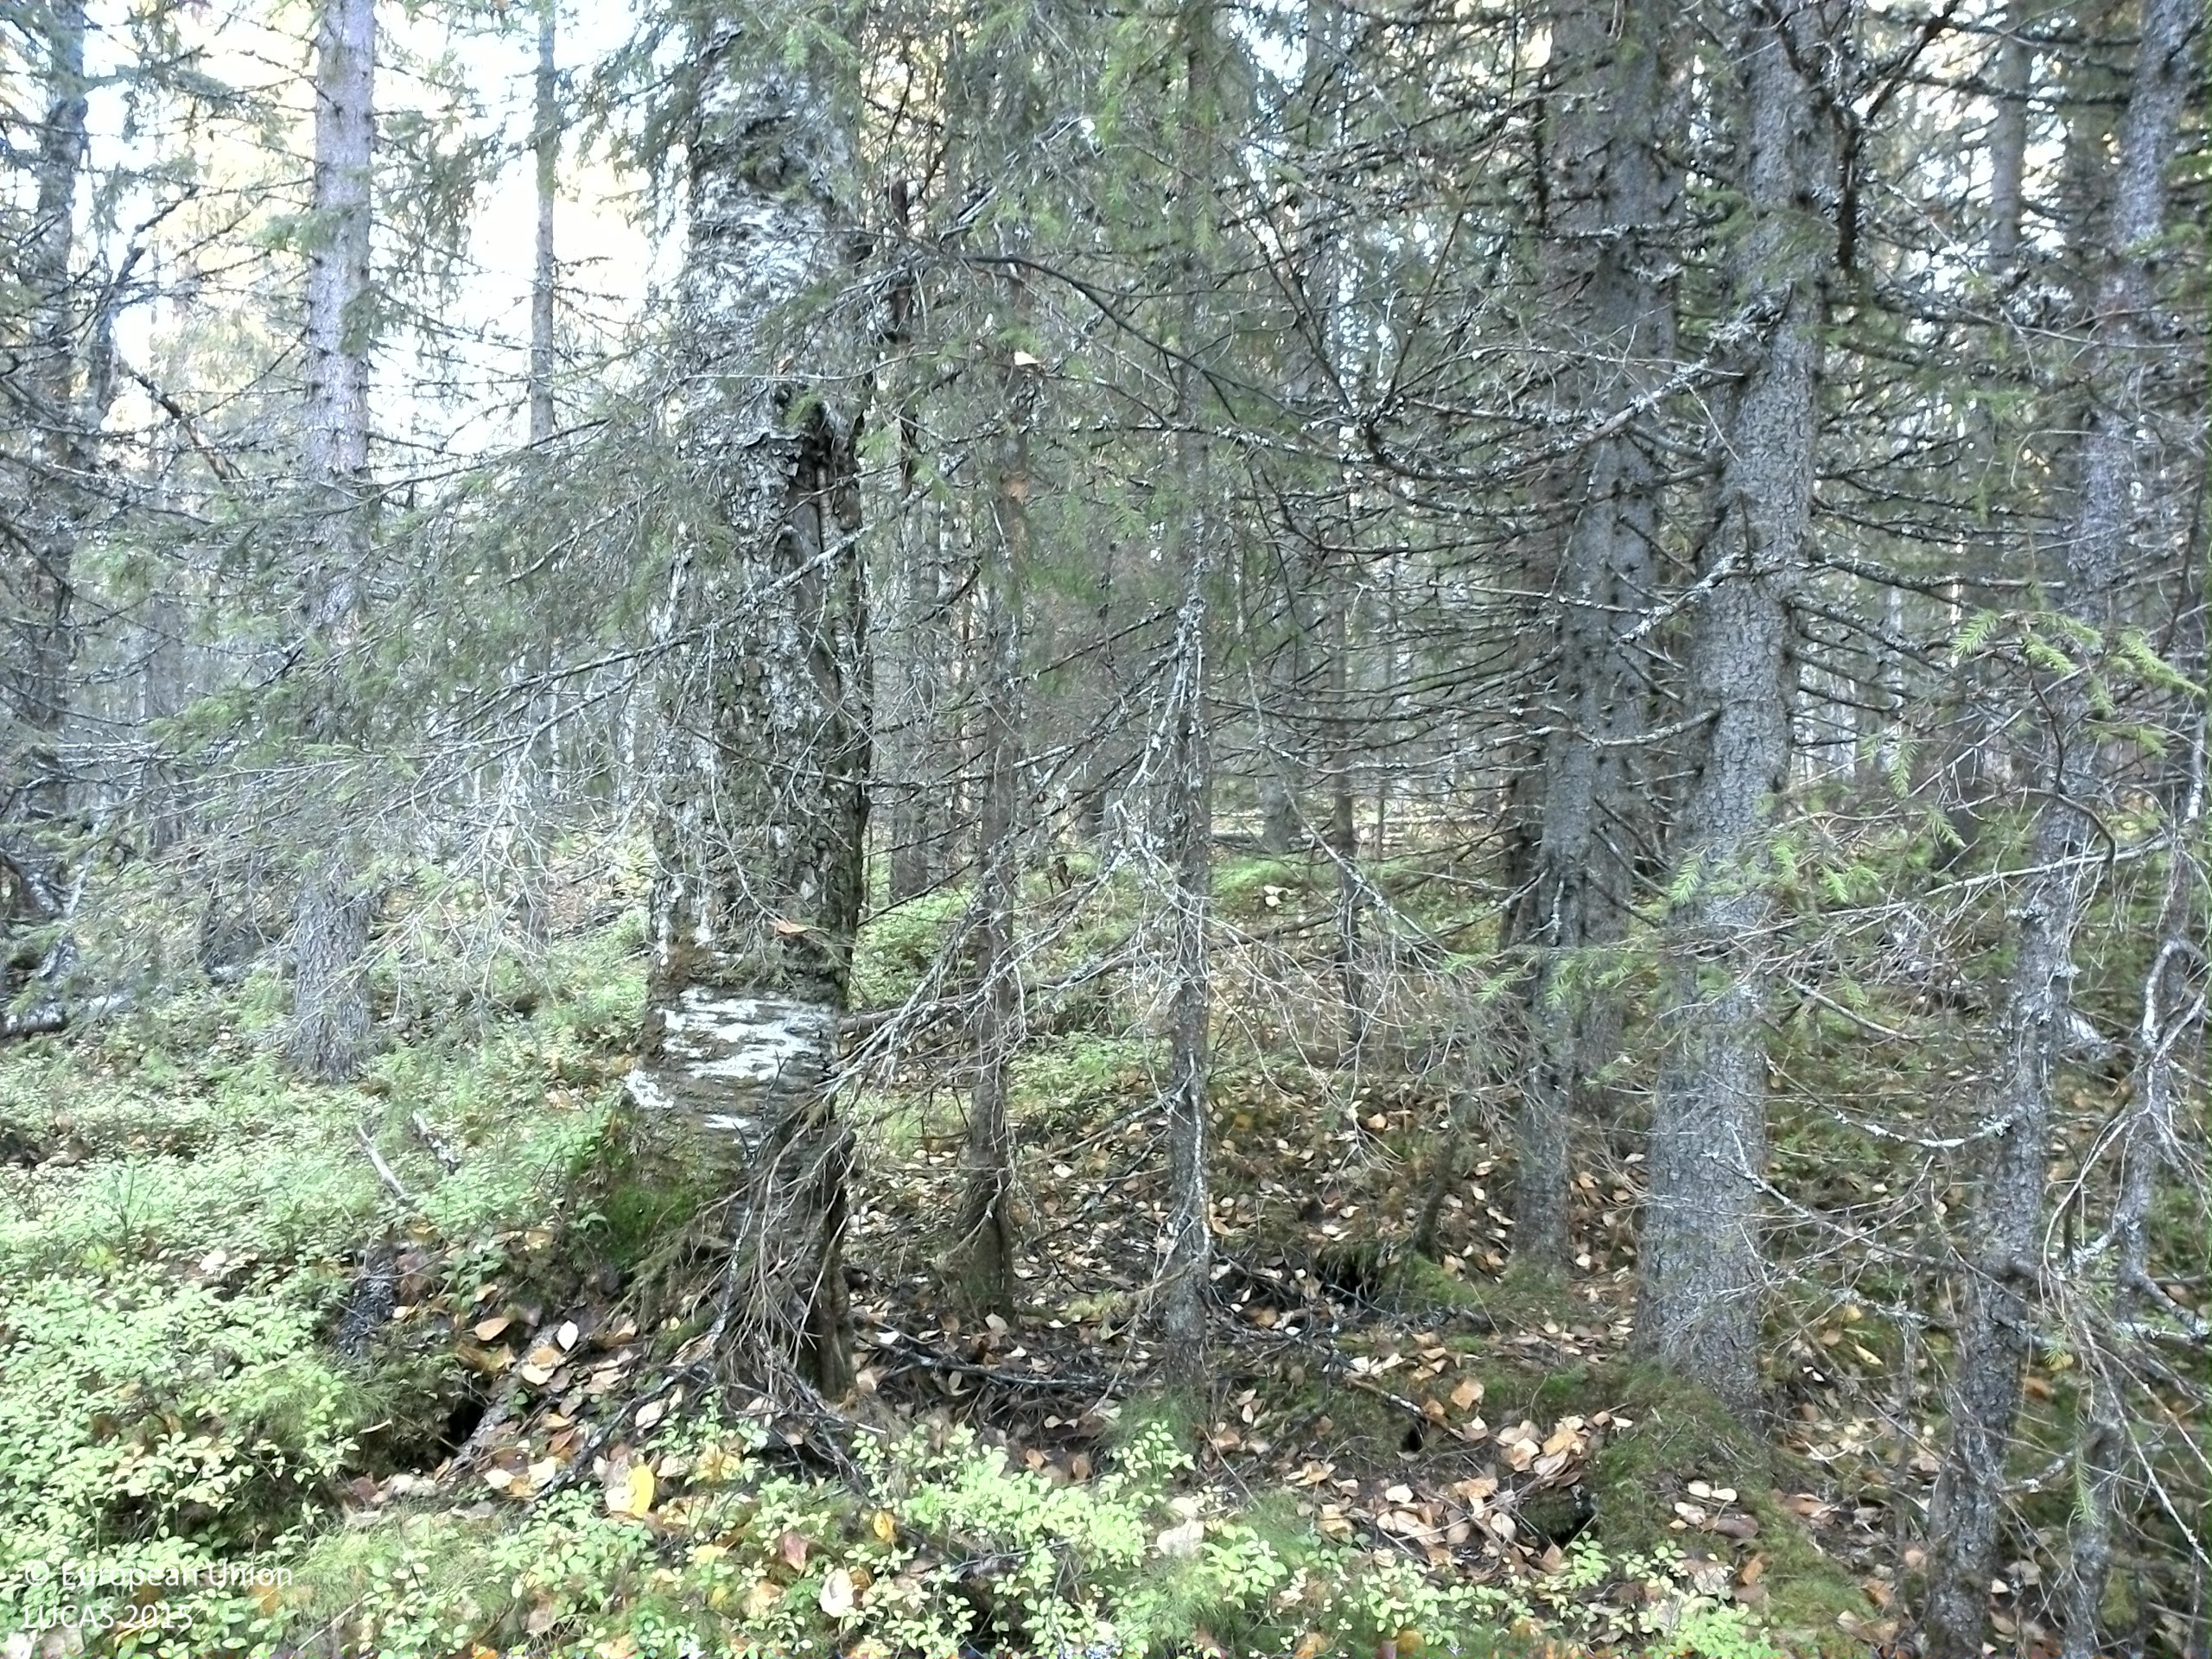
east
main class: Woodland
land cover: Spruce dominated mixed woodland
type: boreal forest
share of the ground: 50 - 75 %
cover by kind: coniferous forest trees 40 %, broadleaved forest trees 20 %, shrubs 20 %, lichens and mosses 15 %, herbaceous plants 5 %
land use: Forestry
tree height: > 5 m
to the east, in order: Spruce dominated mixed woodland
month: October
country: SE
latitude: 64.5757
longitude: 15.4603
